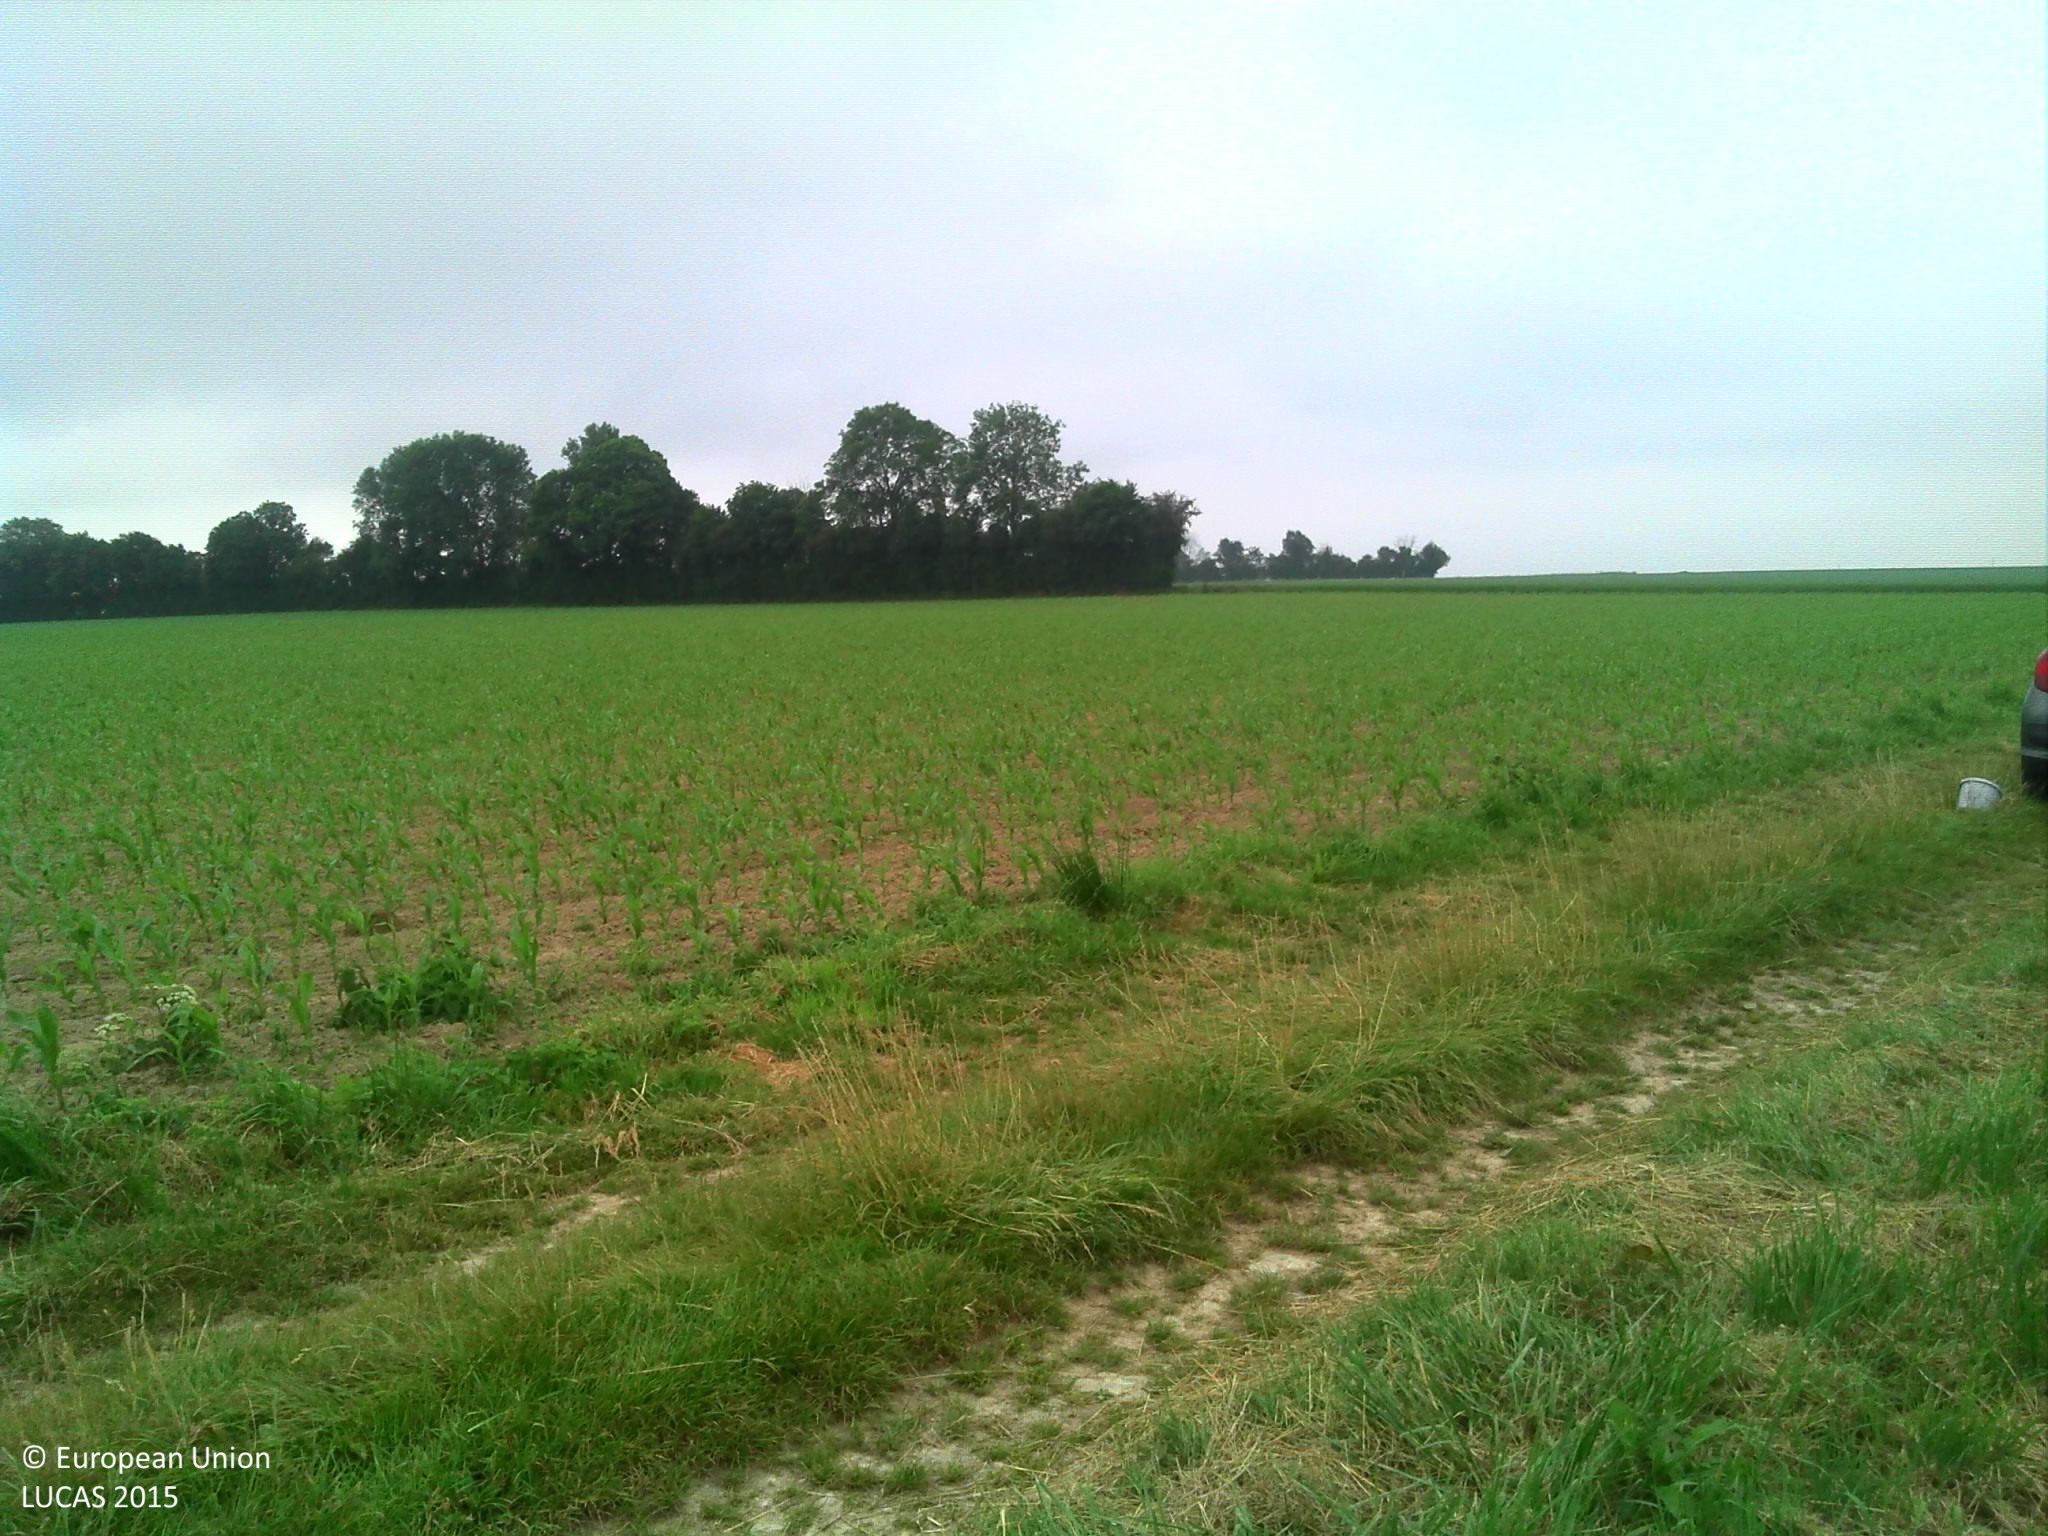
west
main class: Cropland
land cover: Rape and turnip rape
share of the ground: > 75 %
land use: Agriculture (excluding fallow land and kitchen gardens)
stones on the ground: < 10 %
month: June
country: FR
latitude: 48.8210
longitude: -0.1791
